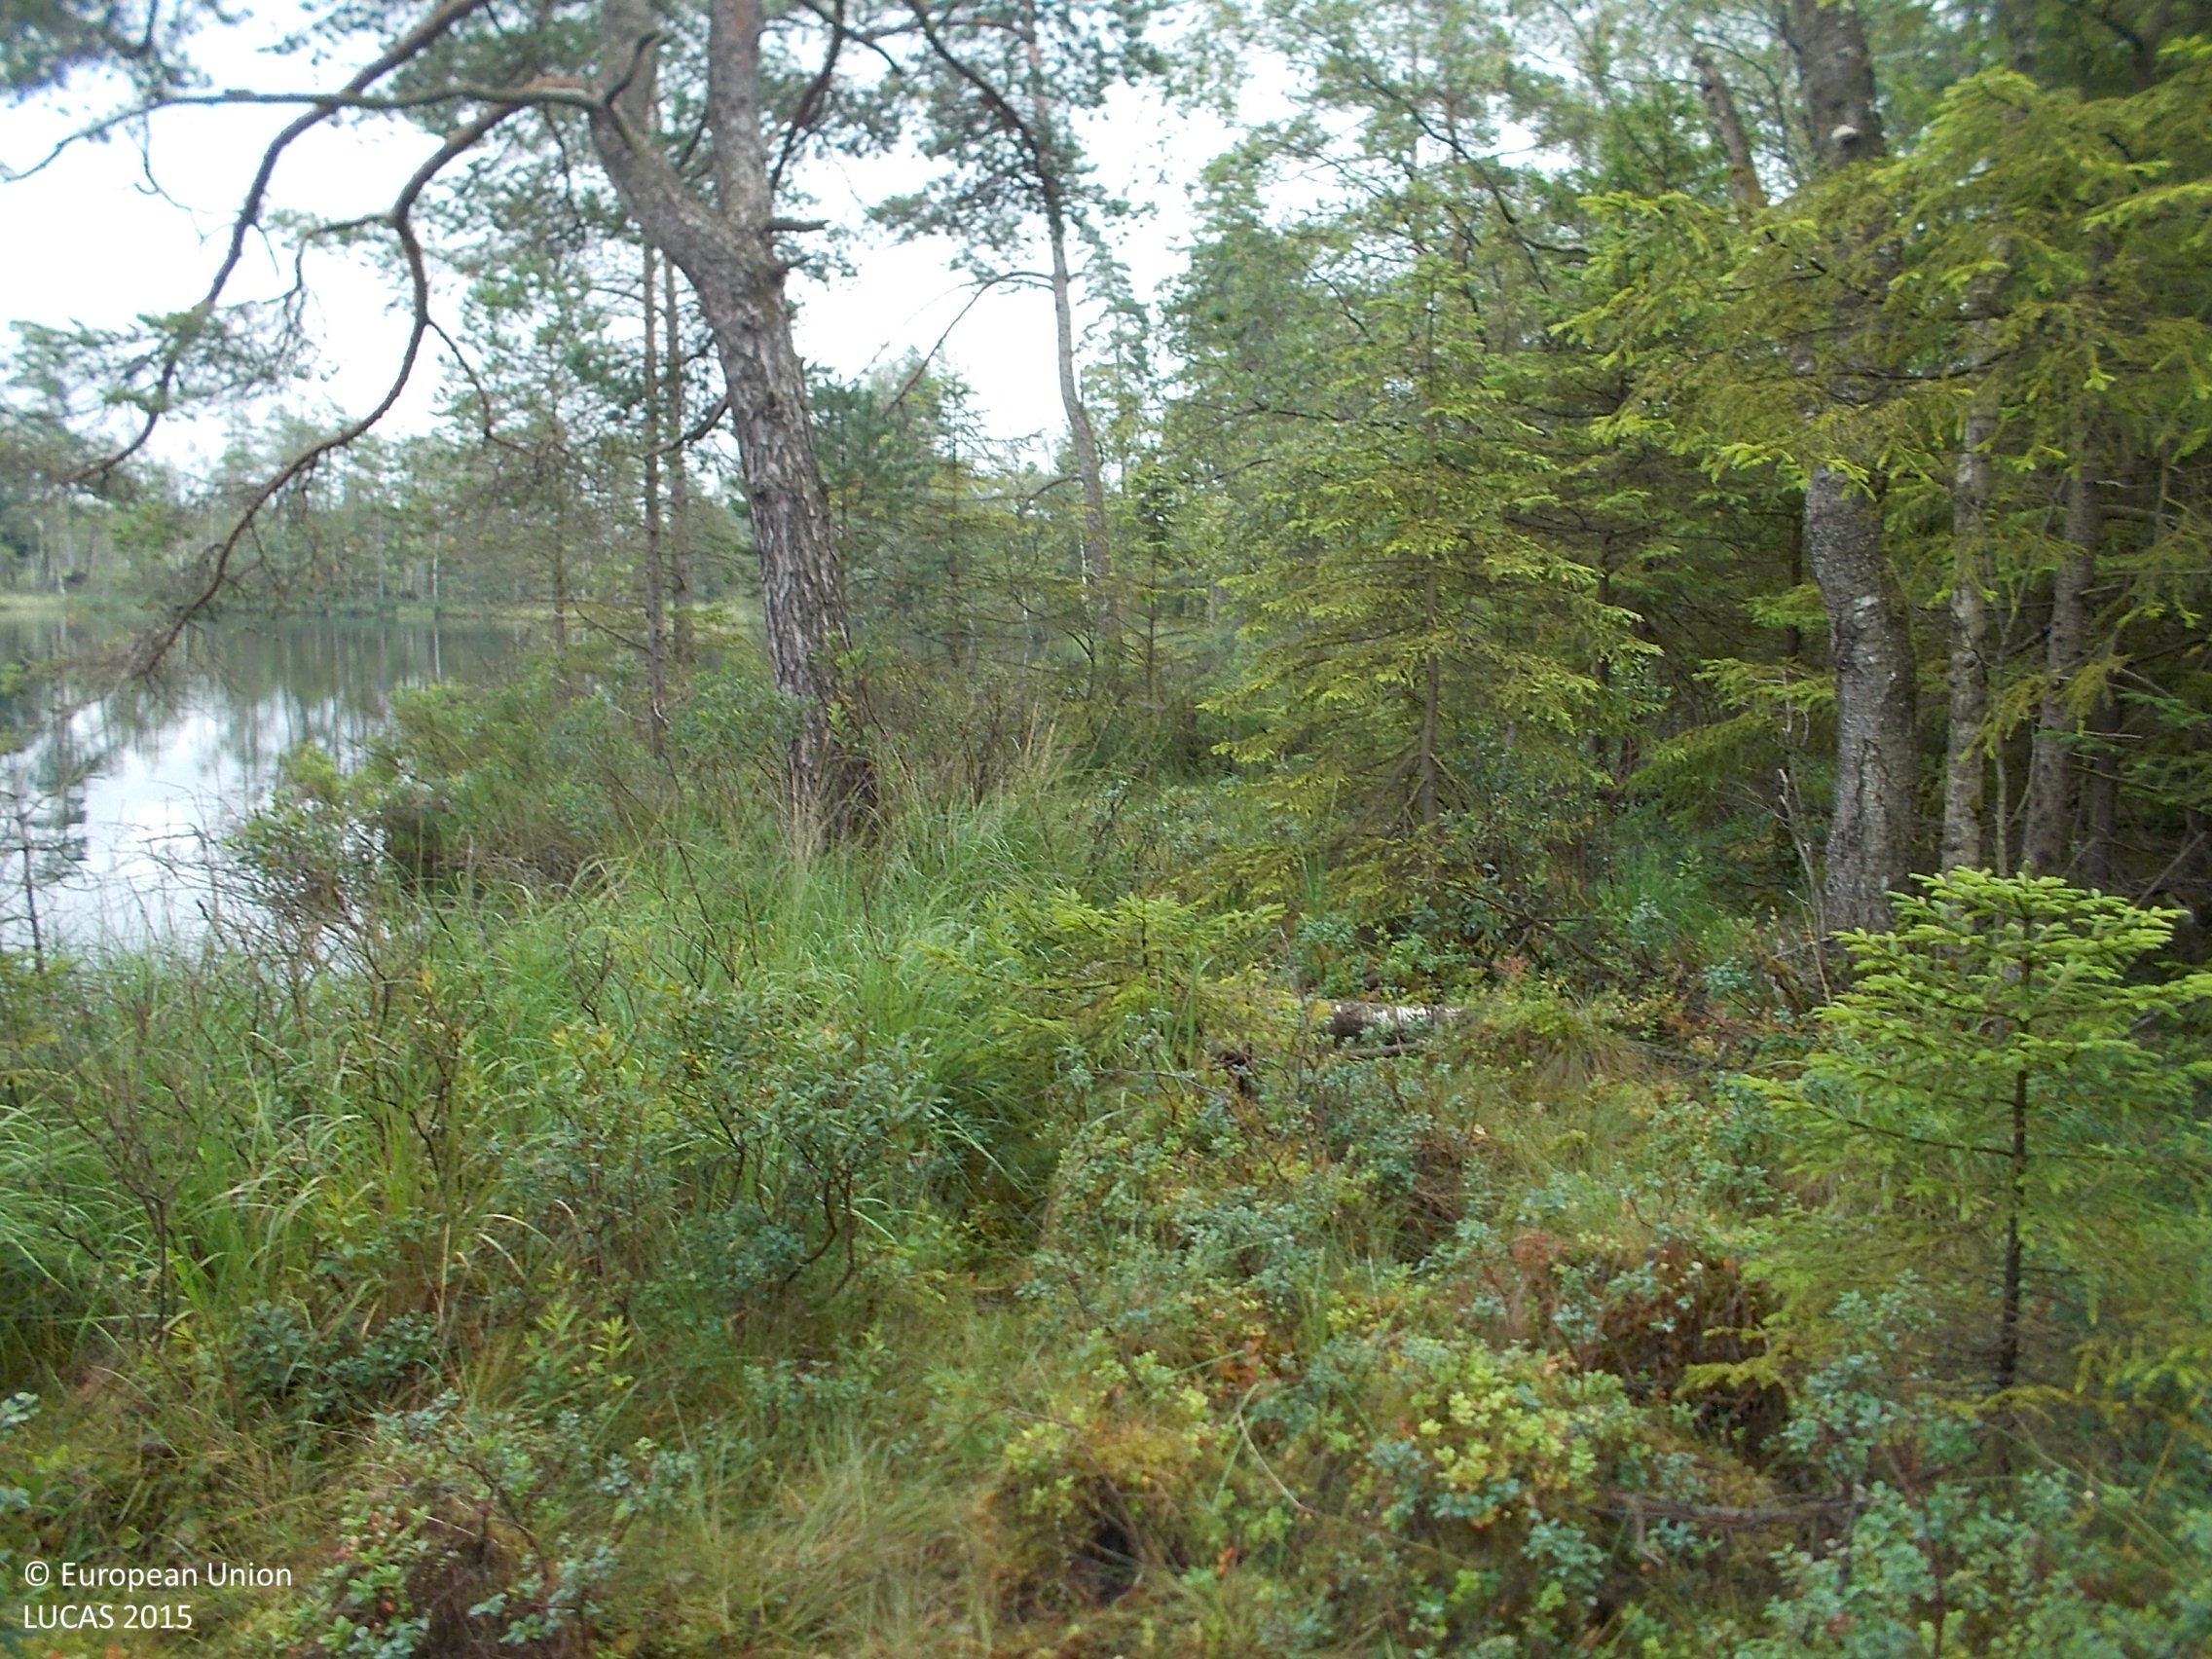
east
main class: Woodland
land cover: Pine dominated mixed woodland
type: boreal forest
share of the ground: > 75 %
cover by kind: coniferous forest trees 60 %, broadleaved forest trees 25 %, shrubs 10 %, lichens and mosses 5 %
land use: Semi-natural and natural areas not in use
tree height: > 5 m
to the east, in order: Pine dominated mixed woodland; Inland fresh water bodies; Pine dominated mixed woodland; Spruce dominated mixed woodland; Ditches and canals; Tracks; Ditches and canals
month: August
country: SE
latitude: 57.5164
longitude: 12.2836
